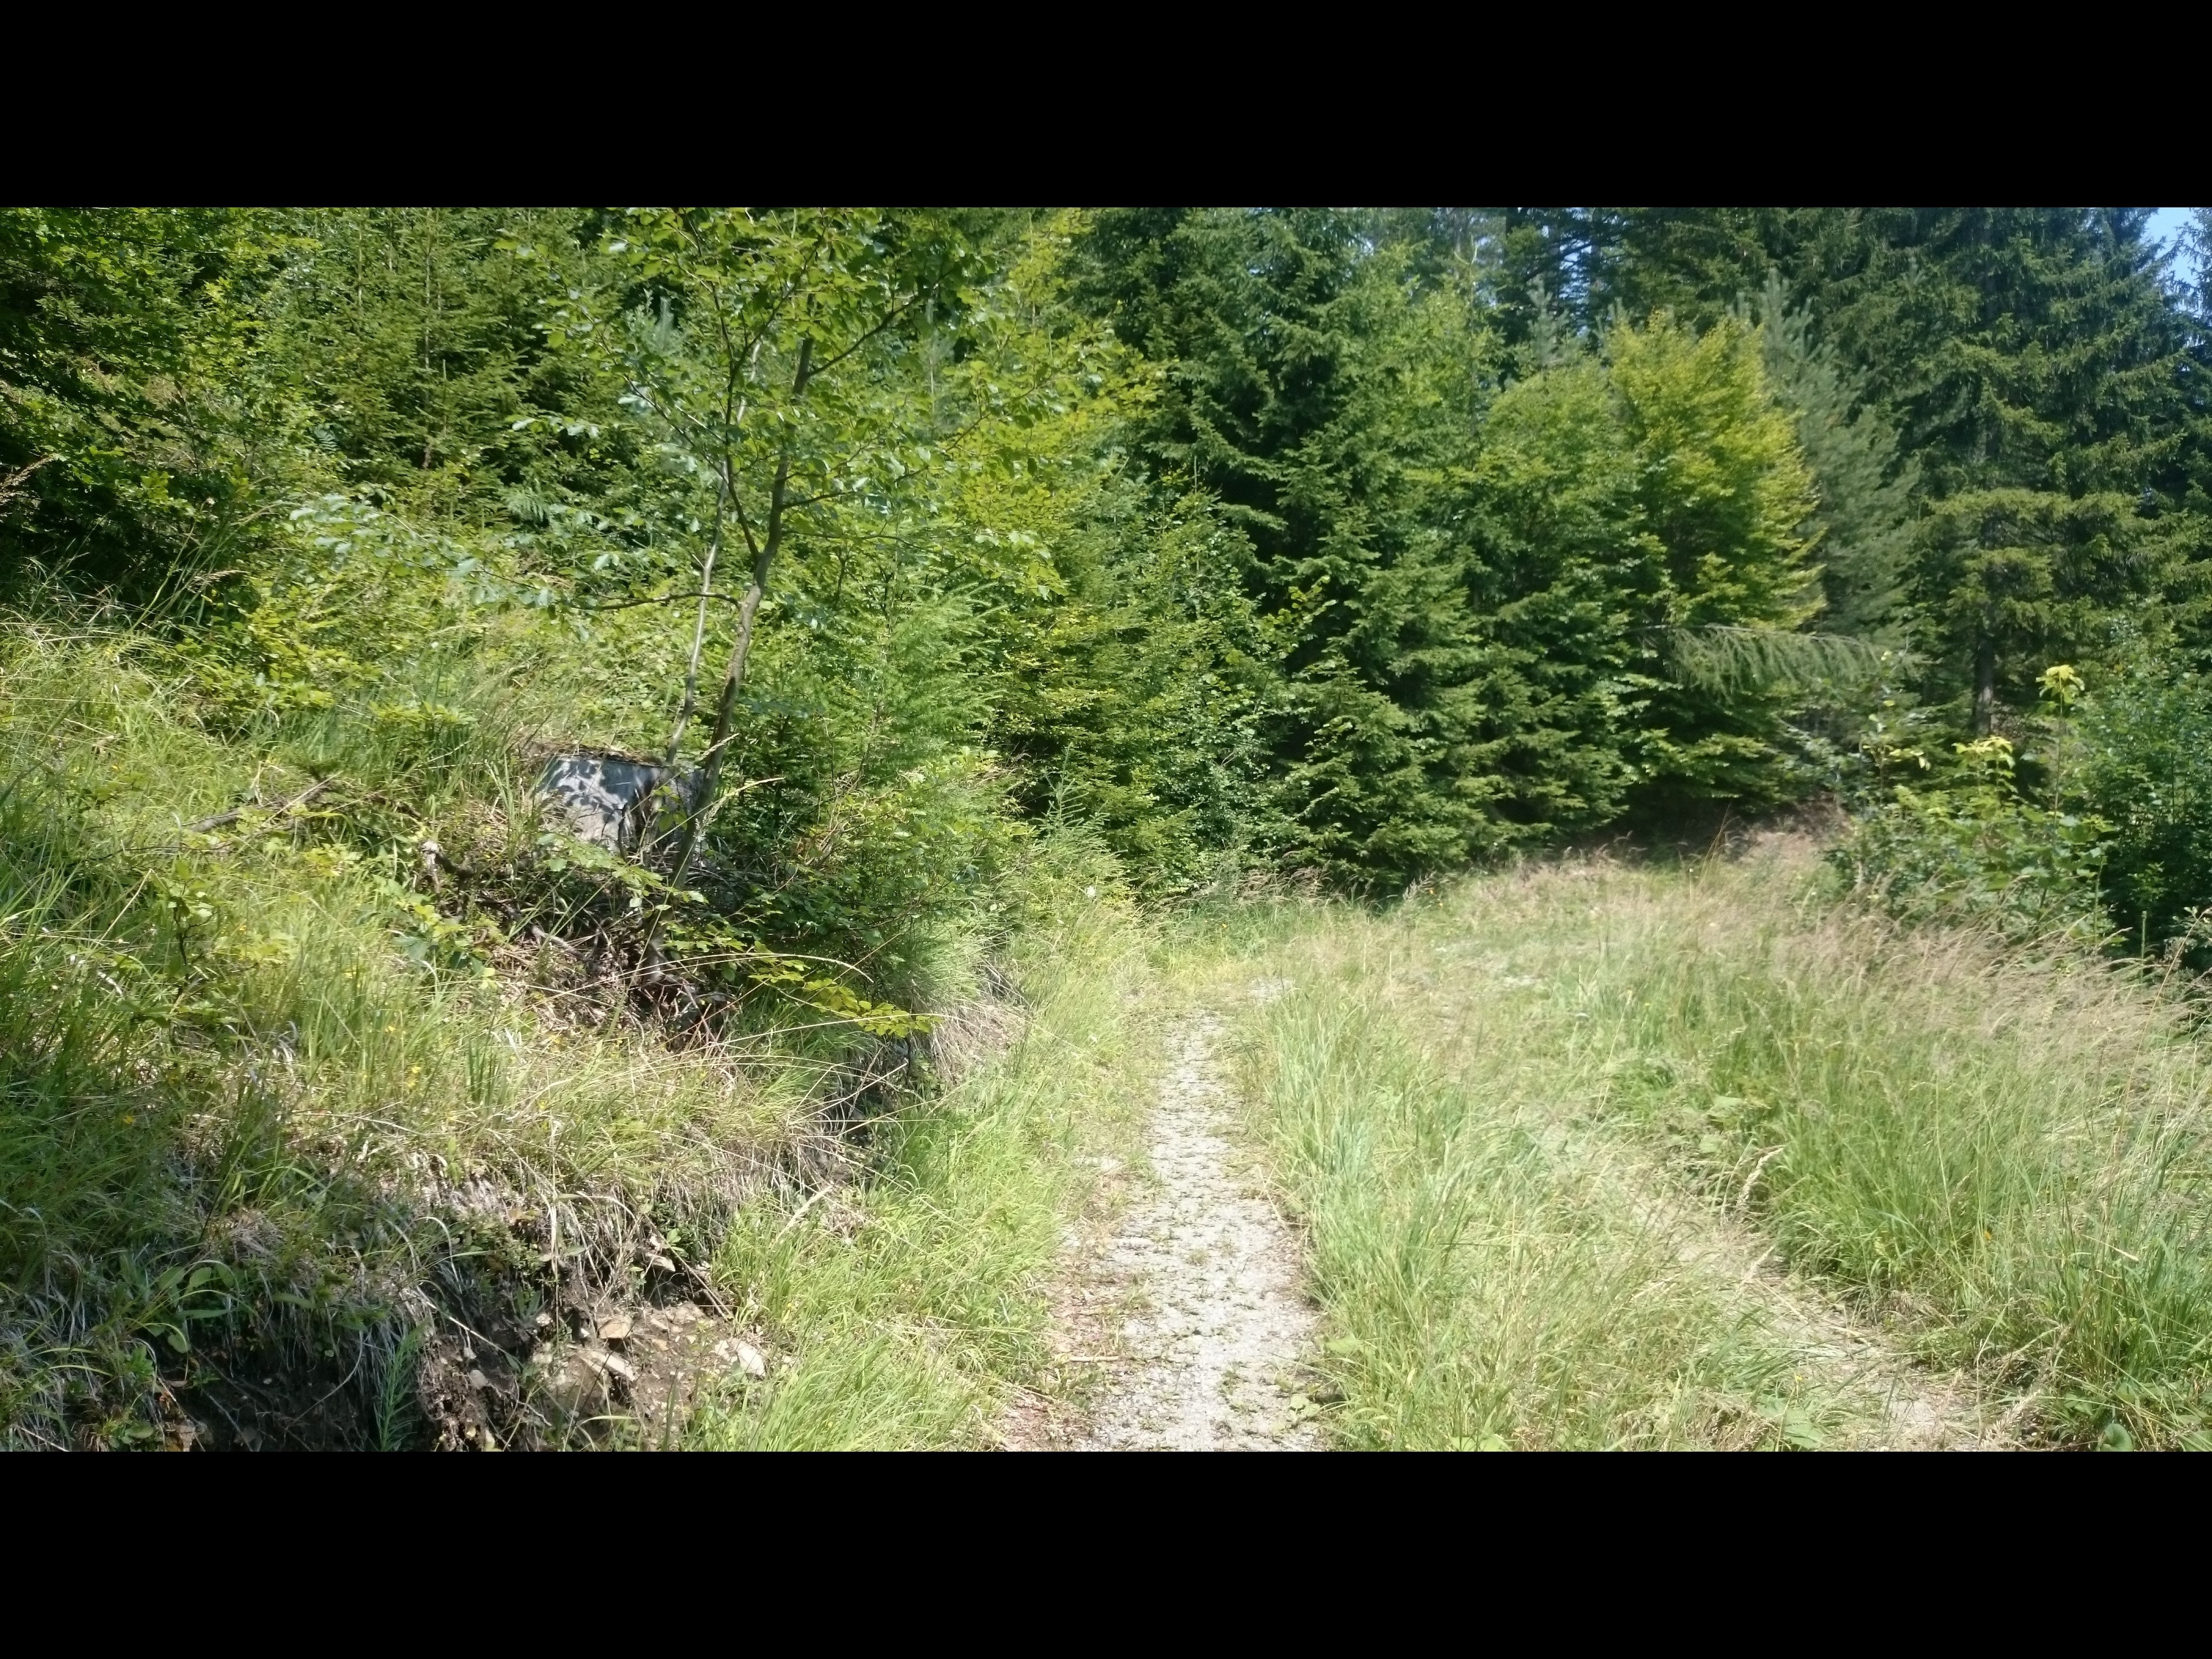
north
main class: Woodland
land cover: Spruce dominated mixed woodland
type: hemiboreal forest and nemoral coniferous forest and mixed broadleaved-coniferous forest
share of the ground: > 75 %
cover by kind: coniferous forest trees 65 %, broadleaved forest trees 25 %, herbaceous plants 10 %
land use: Forestry
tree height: > 5 m
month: July
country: AT
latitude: 47.1855
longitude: 15.4769
